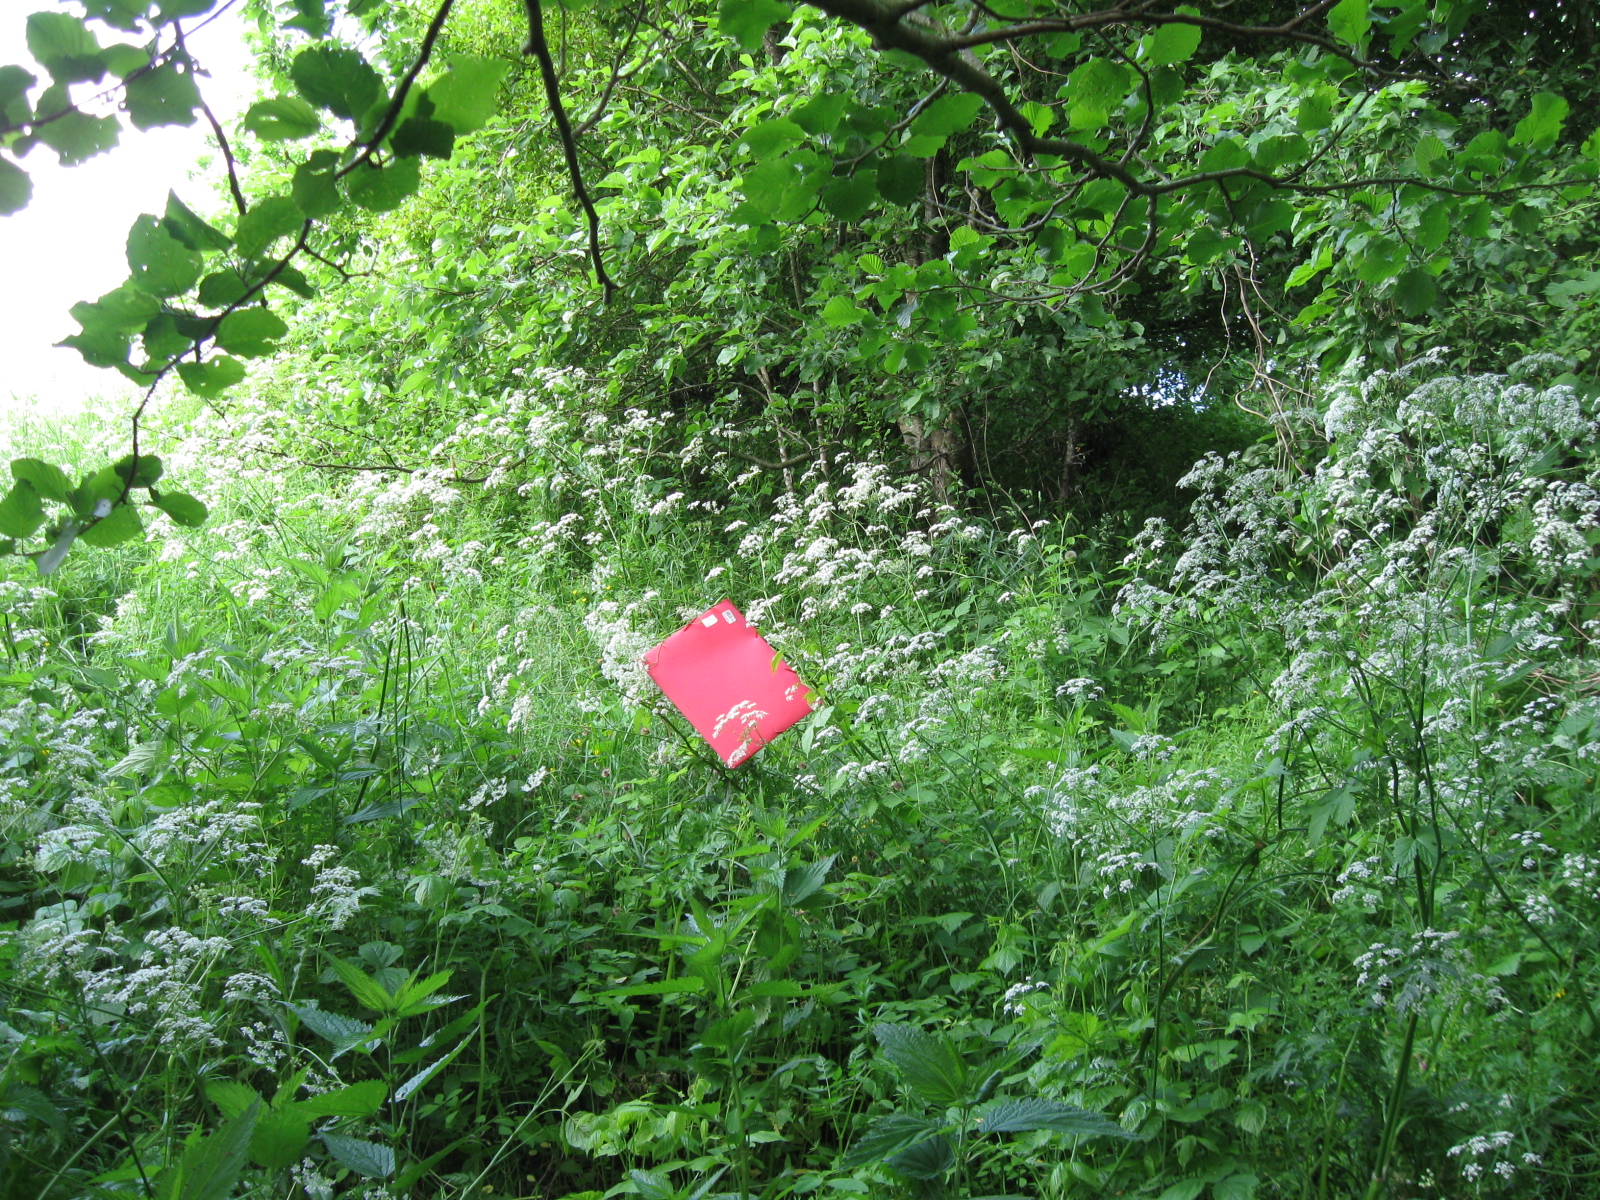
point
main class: Woodland
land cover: Broadleaved woodland
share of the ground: 50 - 75 %
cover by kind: broadleaved forest trees 65 %, herbaceous plants 35 %
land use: Semi-natural and natural areas not in use
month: June
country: LT
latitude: 54.5496
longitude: 23.8957
